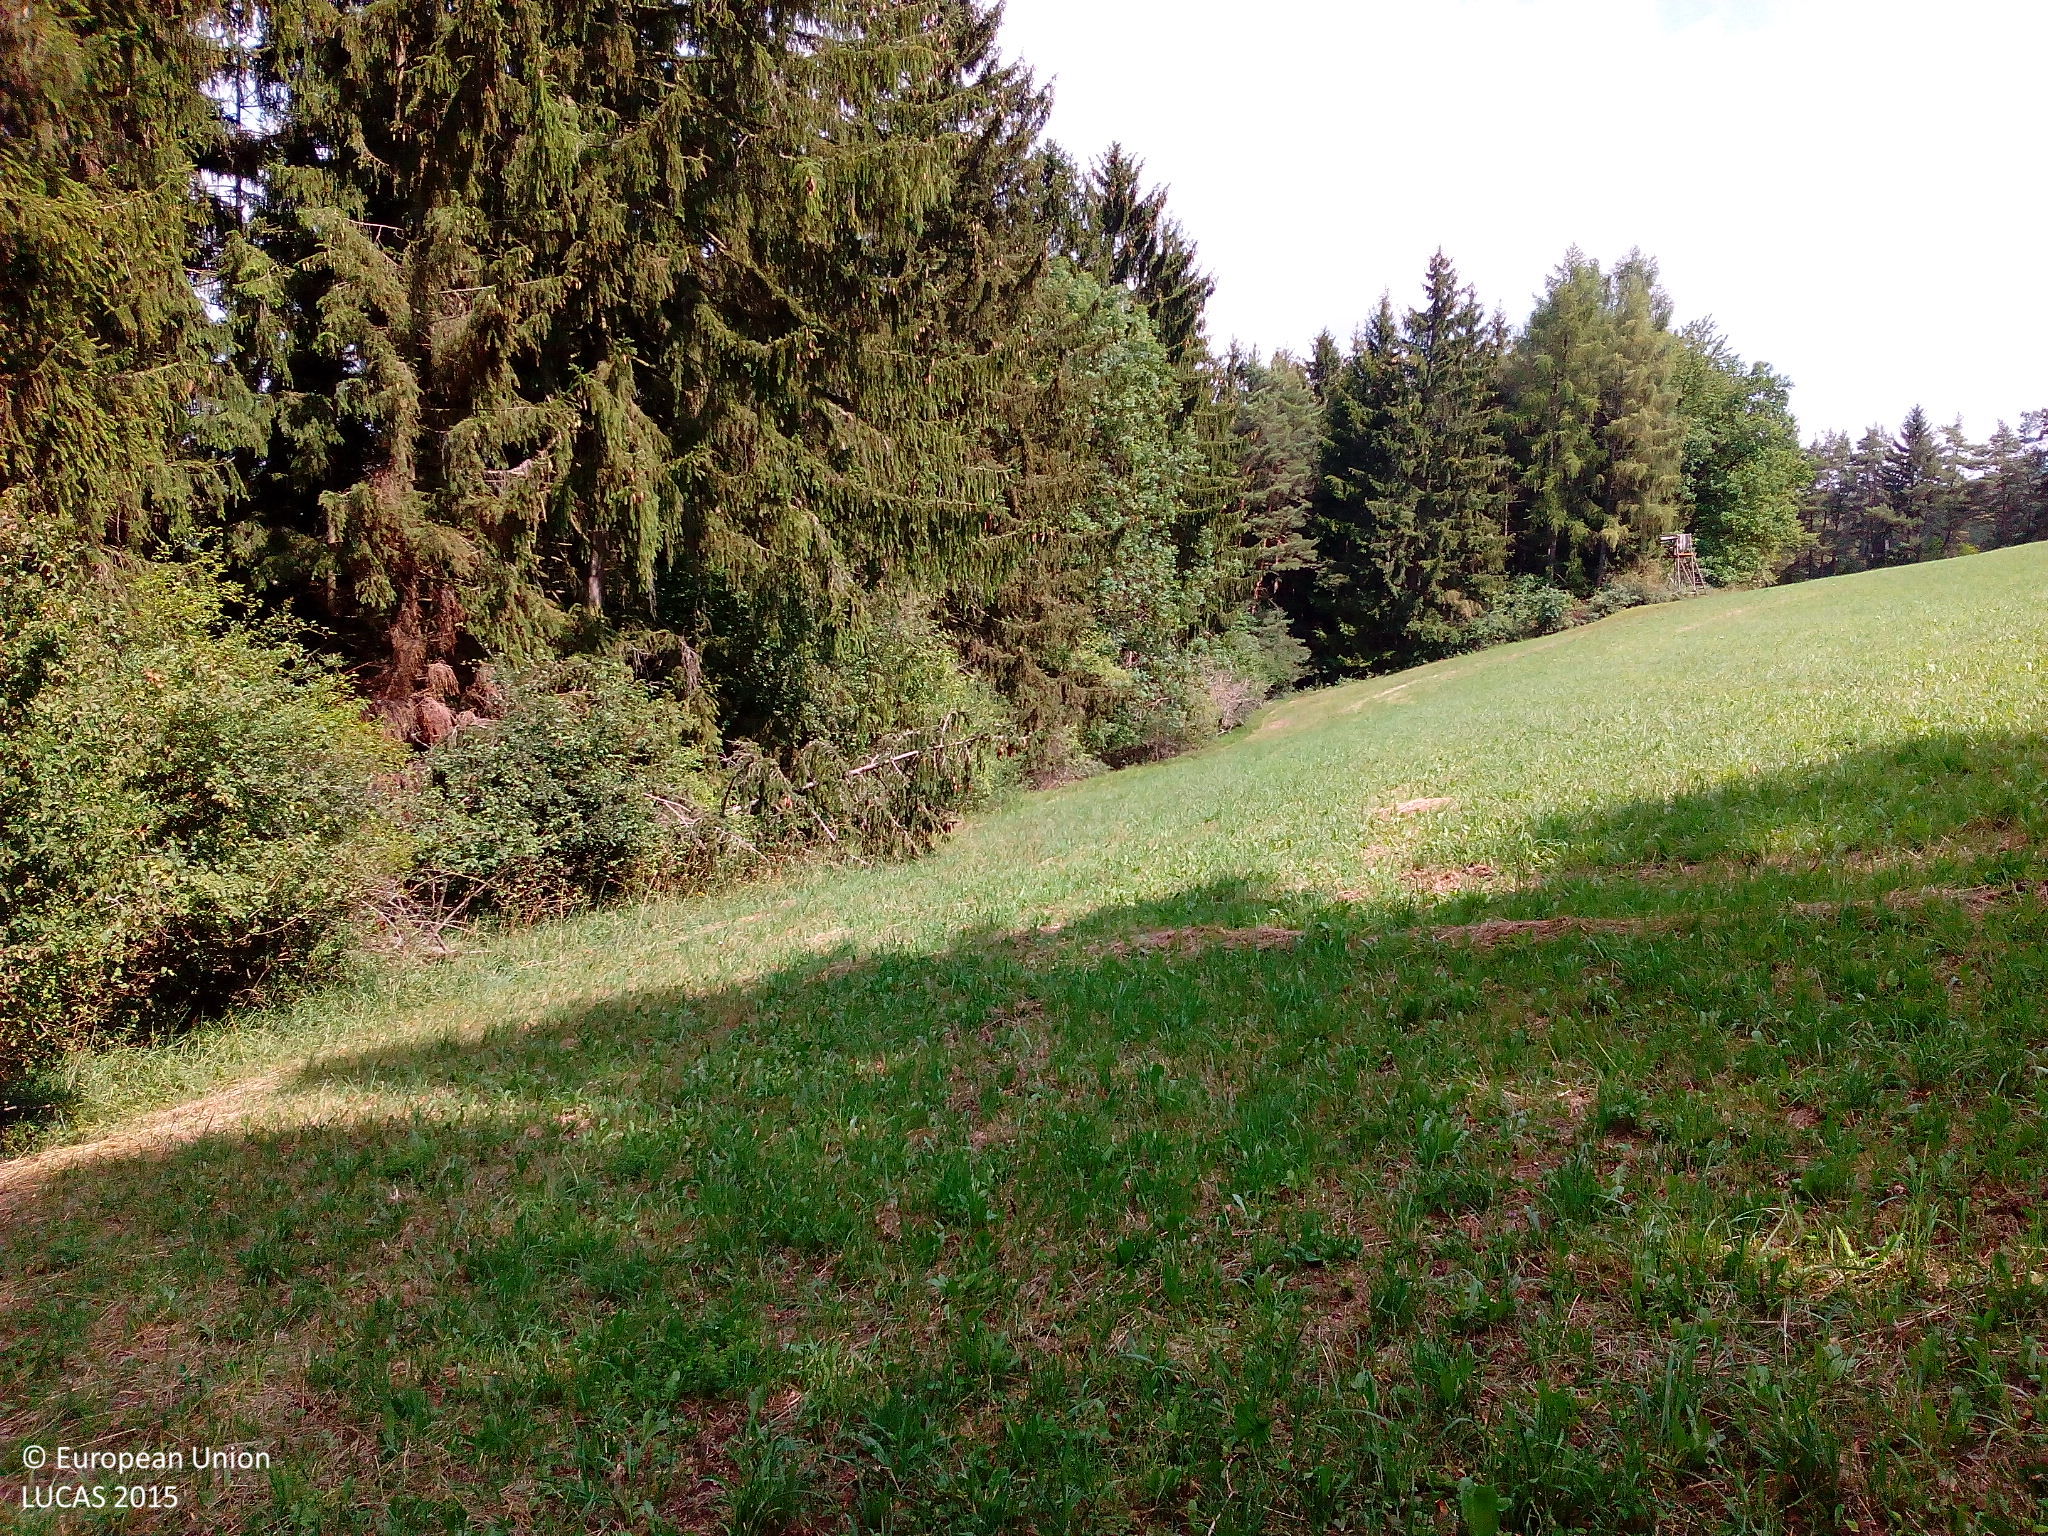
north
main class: Grassland
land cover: Grassland without tree/shrub cover
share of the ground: > 75 %
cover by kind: herbaceous plants 100 %
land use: Agriculture (excluding fallow land and kitchen gardens)
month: July
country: DE
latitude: 50.6697
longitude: 9.9293
